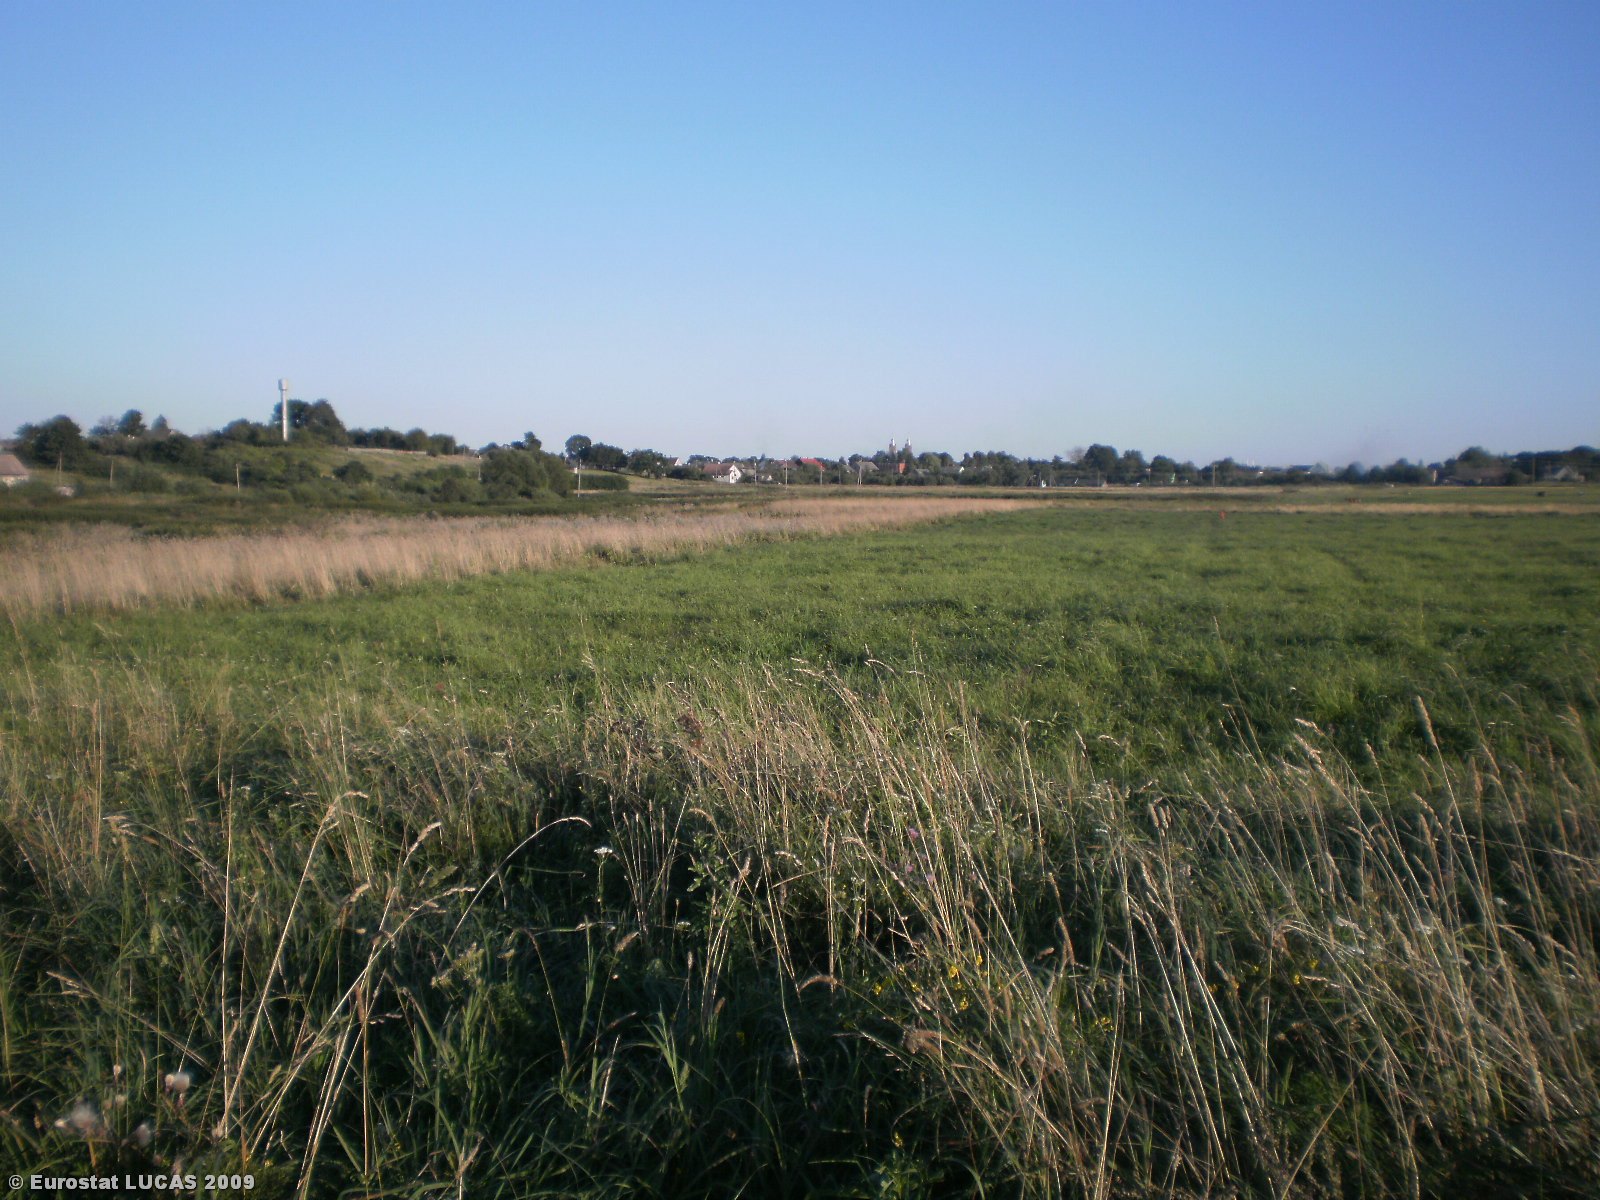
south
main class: Grassland
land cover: Grassland without tree/shrub cover
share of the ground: > 75 %
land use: Agriculture (excluding fallow land and kitchen gardens)
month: August
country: LT
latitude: 54.8726
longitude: 24.5811
